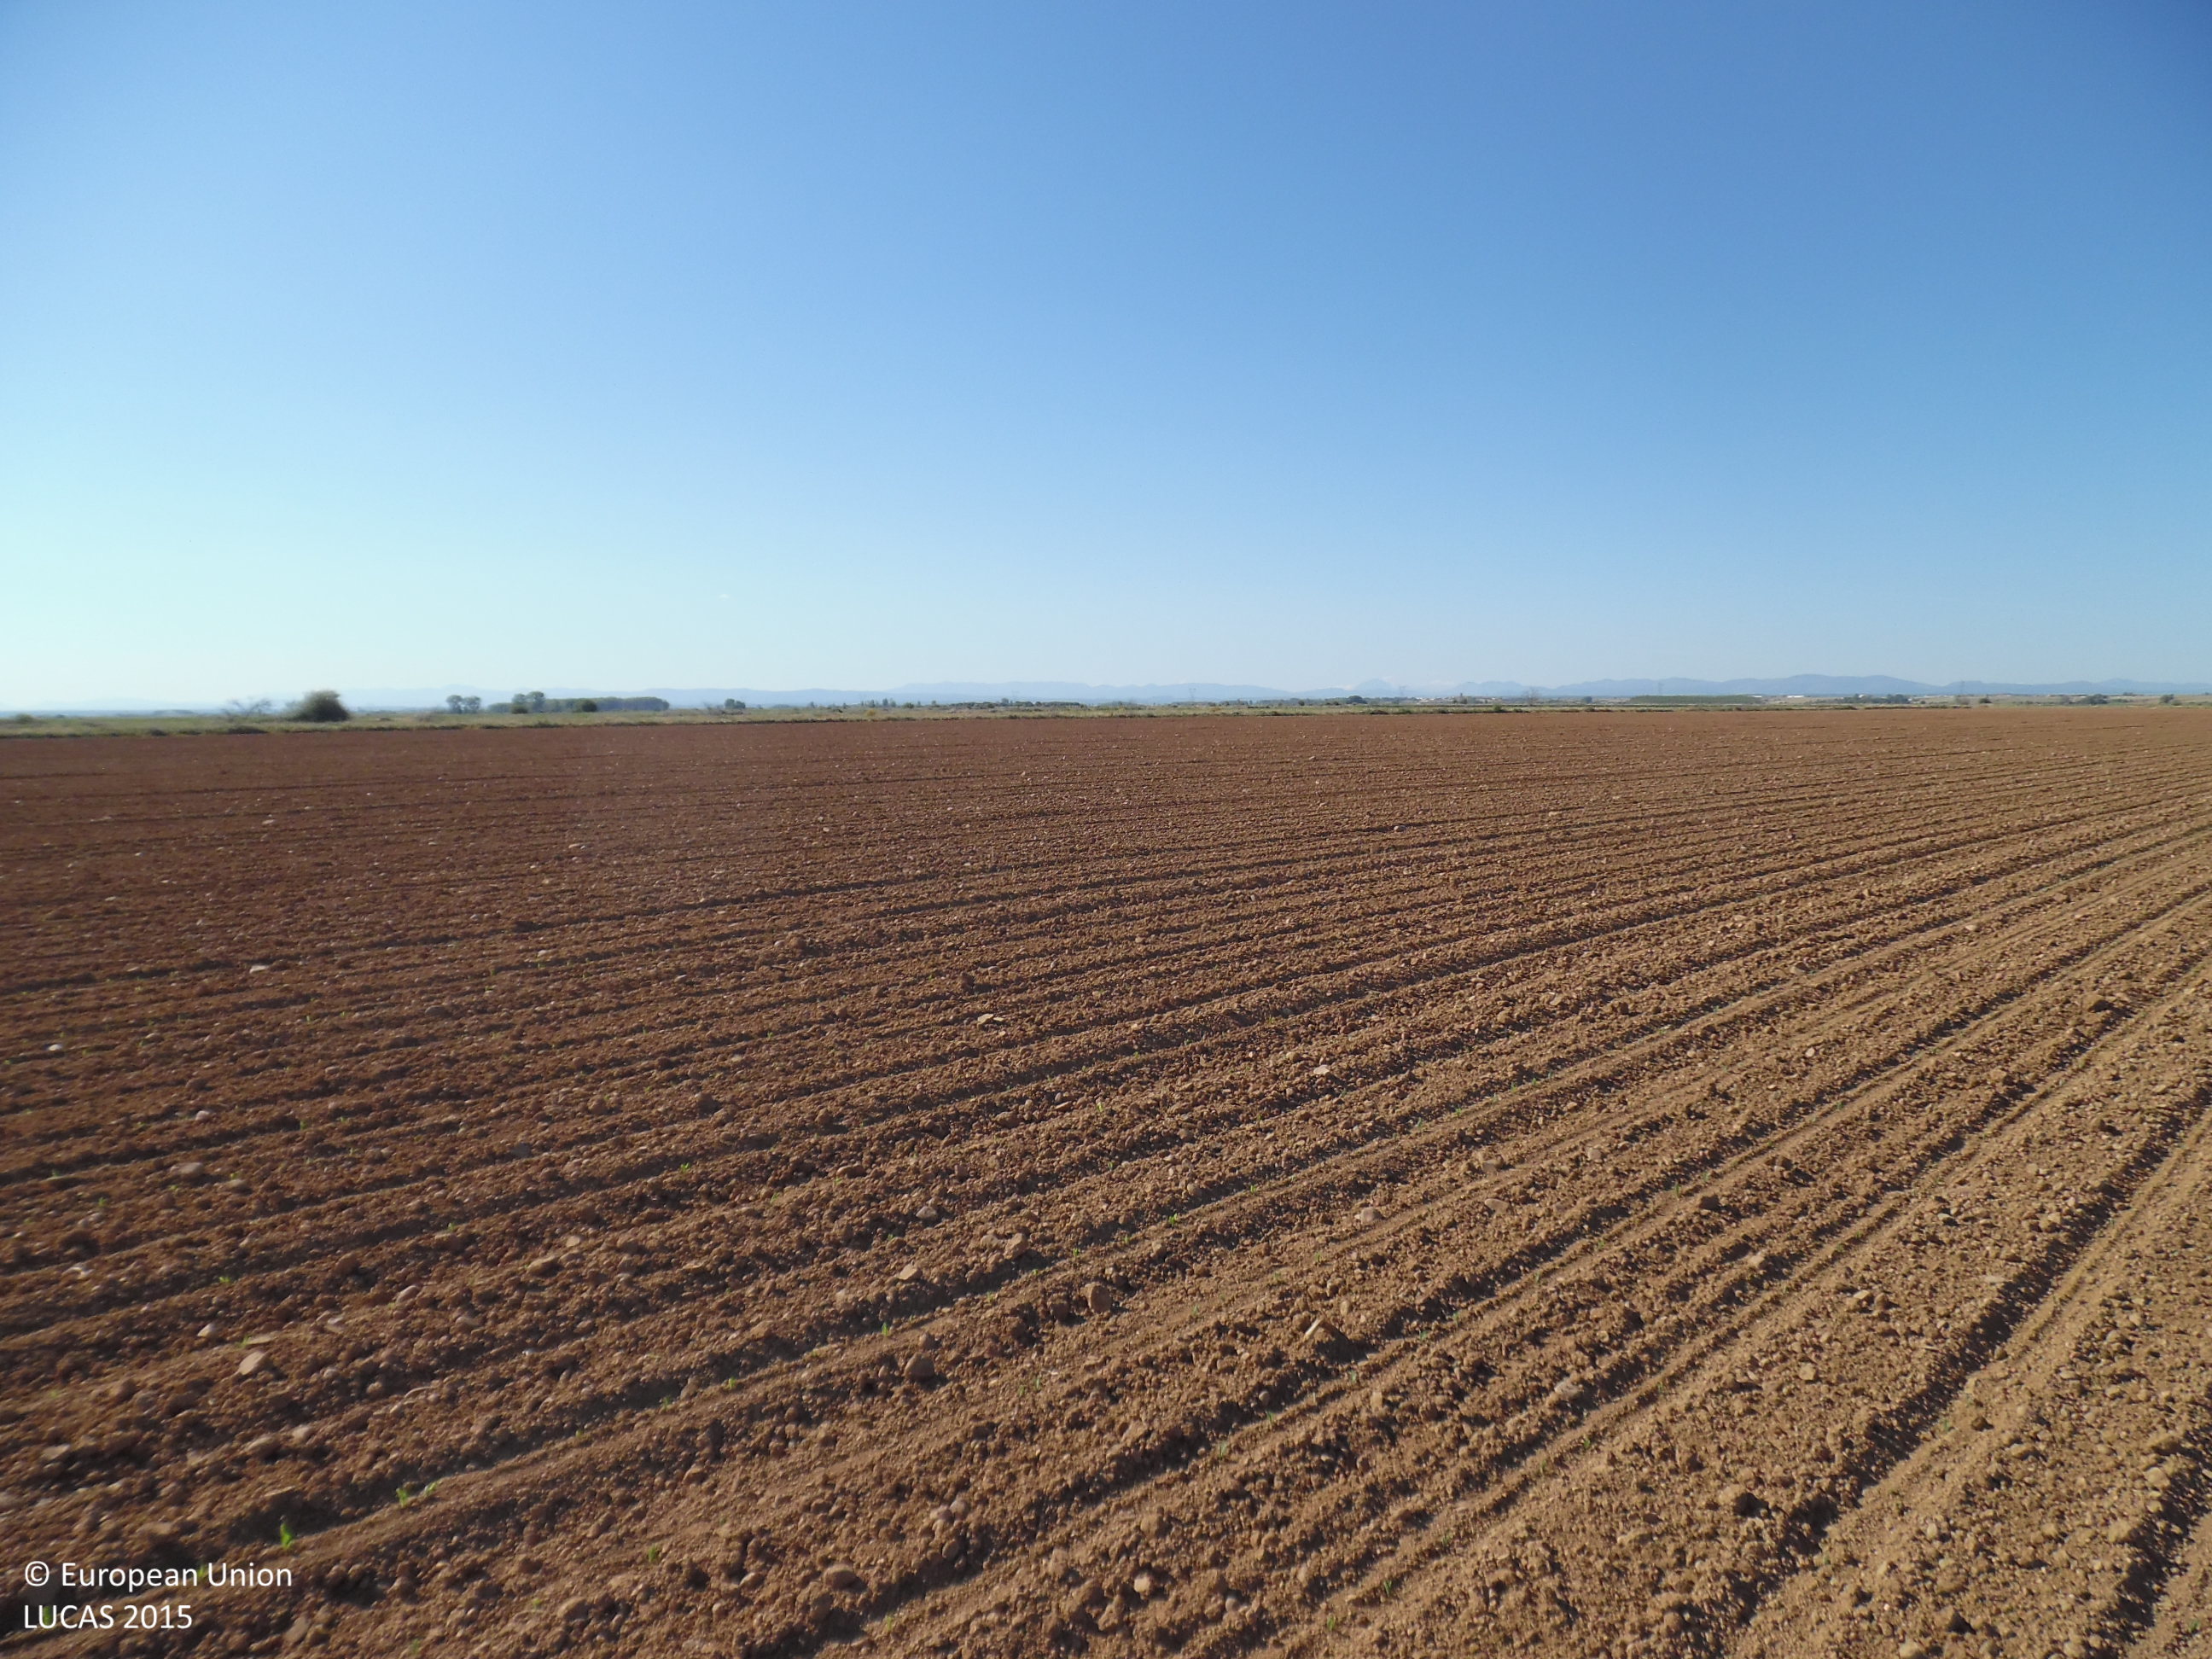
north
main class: Cropland
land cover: Maize
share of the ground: < 10 %
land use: Agriculture (excluding fallow land and kitchen gardens)
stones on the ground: 10 - 25 %
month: June
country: ES
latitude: 42.4595
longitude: -5.7500
